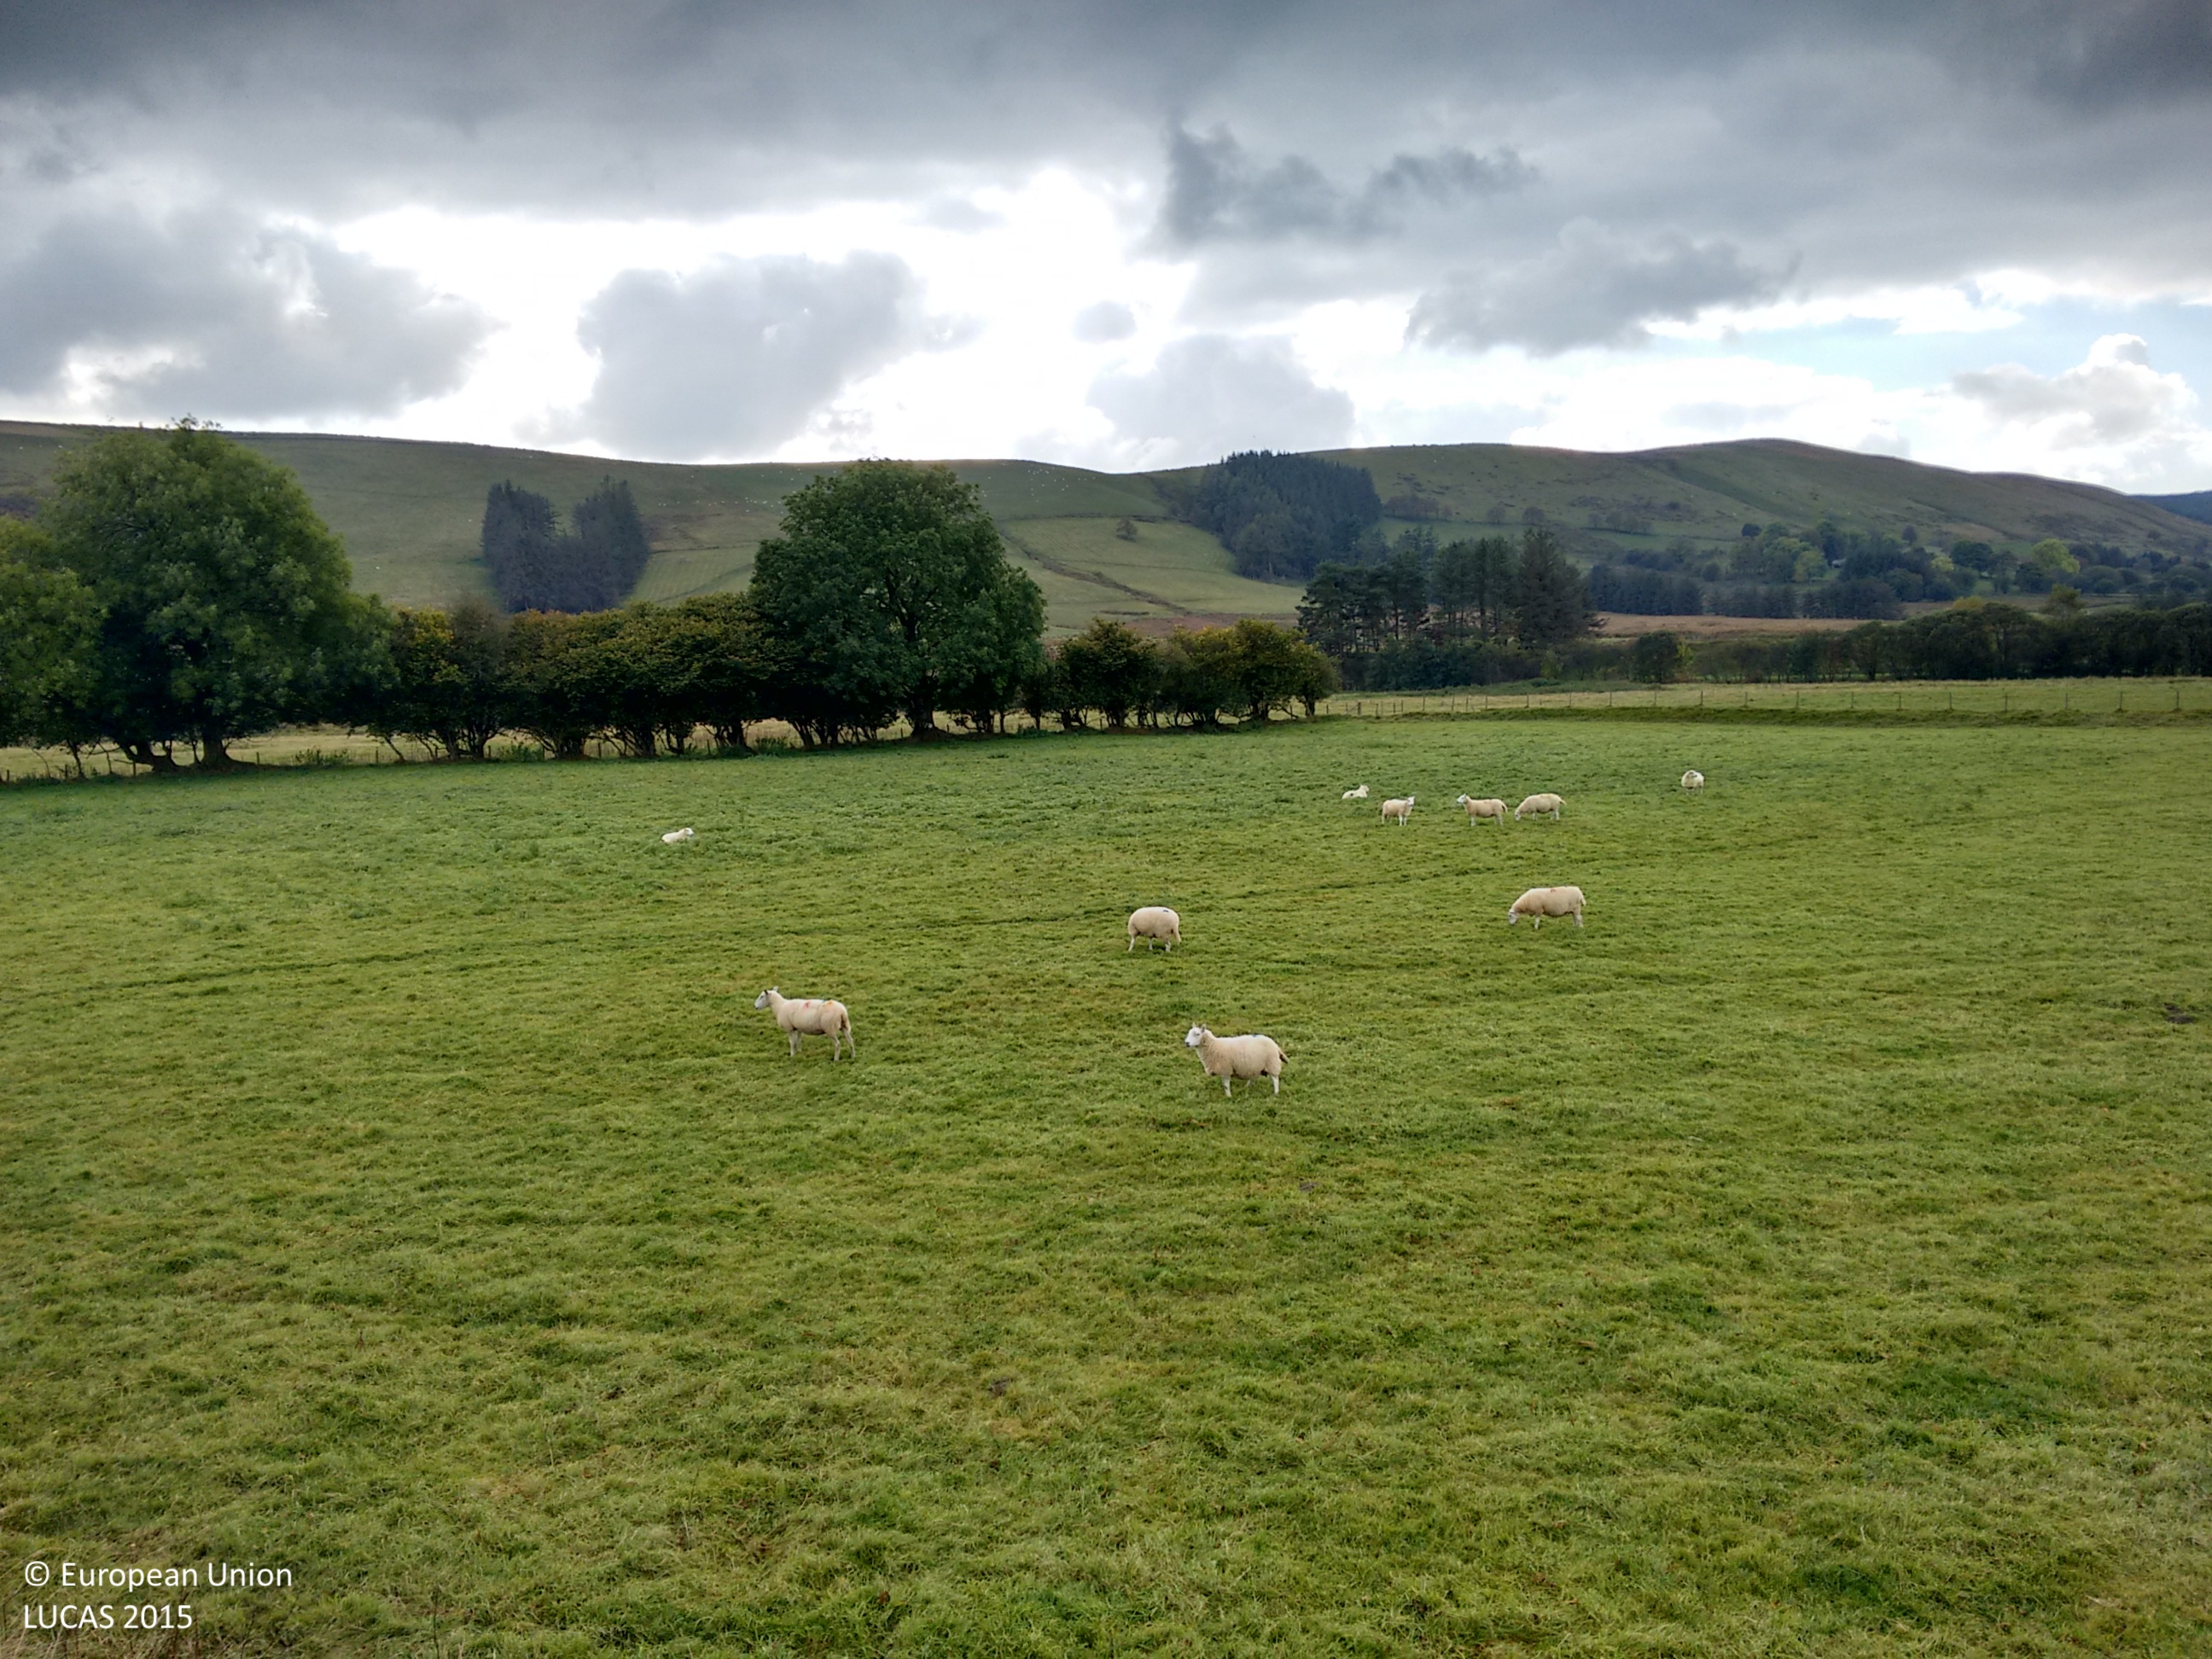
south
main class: Grassland
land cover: Grassland without tree/shrub cover
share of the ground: > 75 %
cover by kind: herbaceous plants 100 %
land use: Agriculture (excluding fallow land and kitchen gardens)
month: October
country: GB
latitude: 52.4080
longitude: -3.6256
